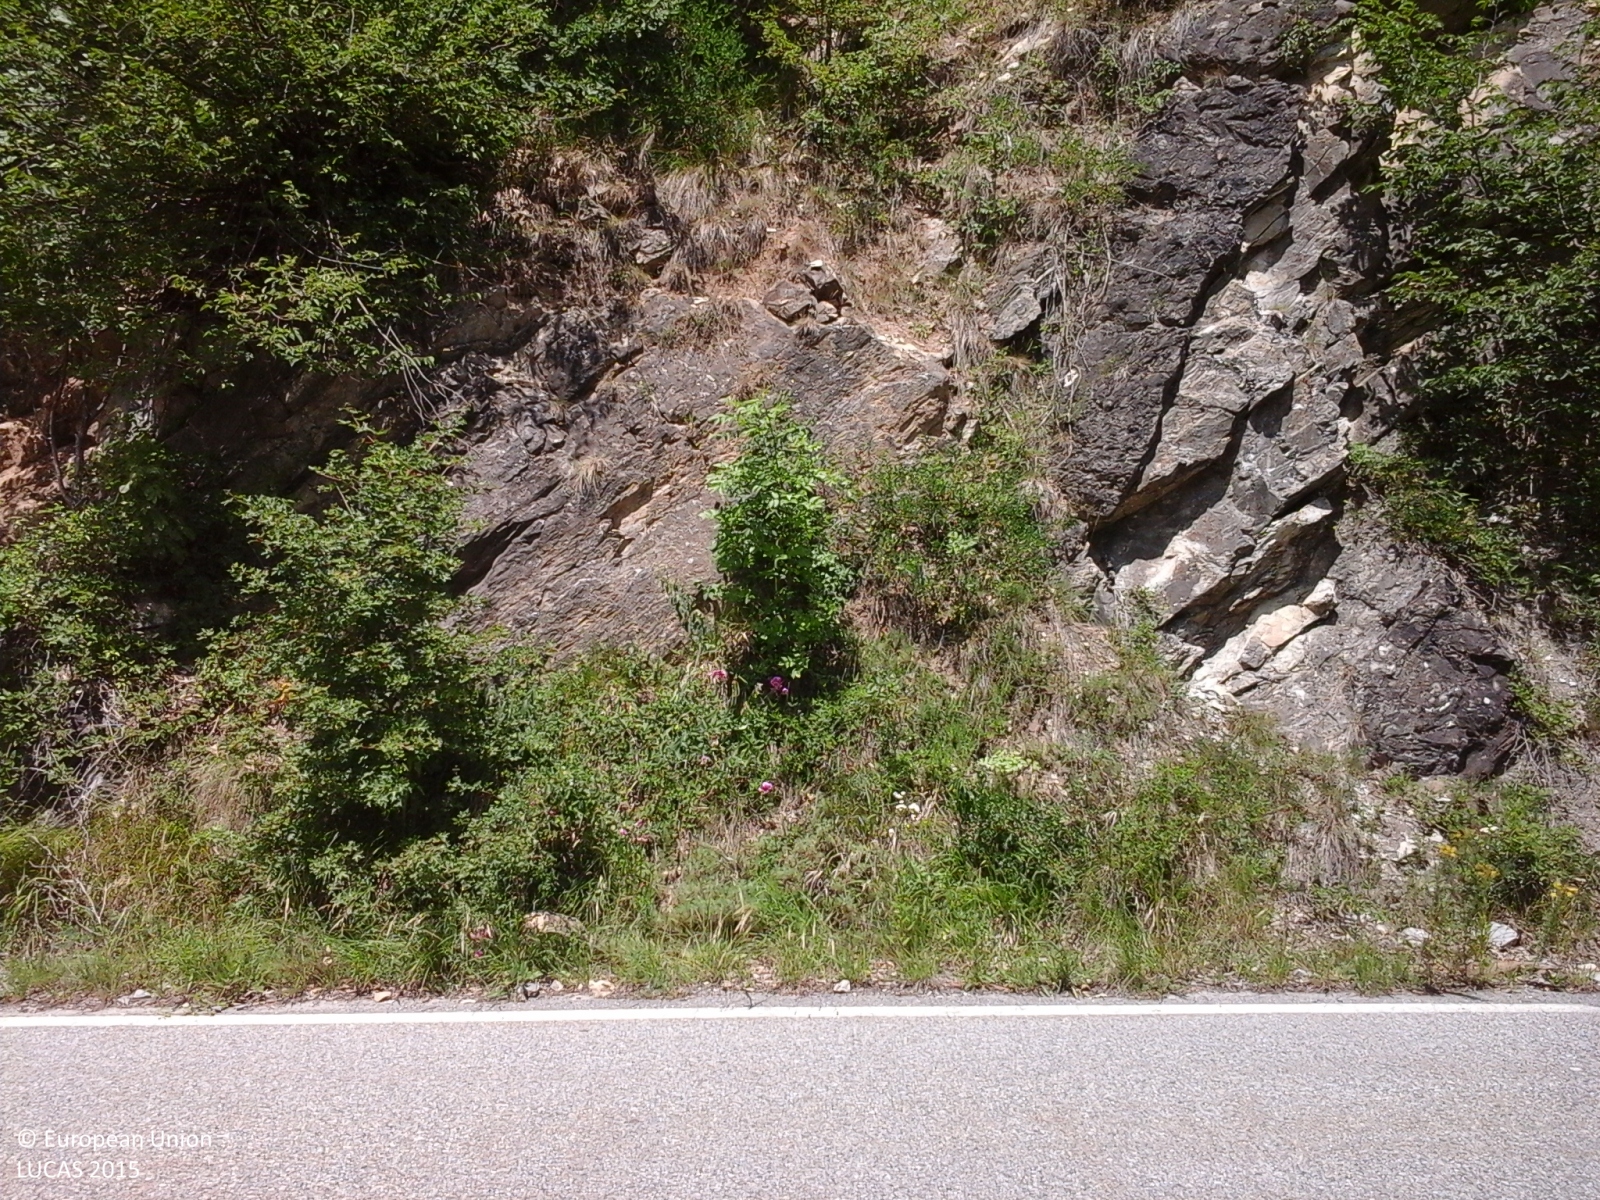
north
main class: Woodland
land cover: Broadleaved woodland
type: thermophilous deciduous forest
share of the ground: > 75 %
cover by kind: broadleaved forest trees 90 %, shrubs 5 %, herbaceous plants 5 %
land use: Forestry
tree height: > 5 m
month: June
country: IT
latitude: 44.6357
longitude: 9.1572
